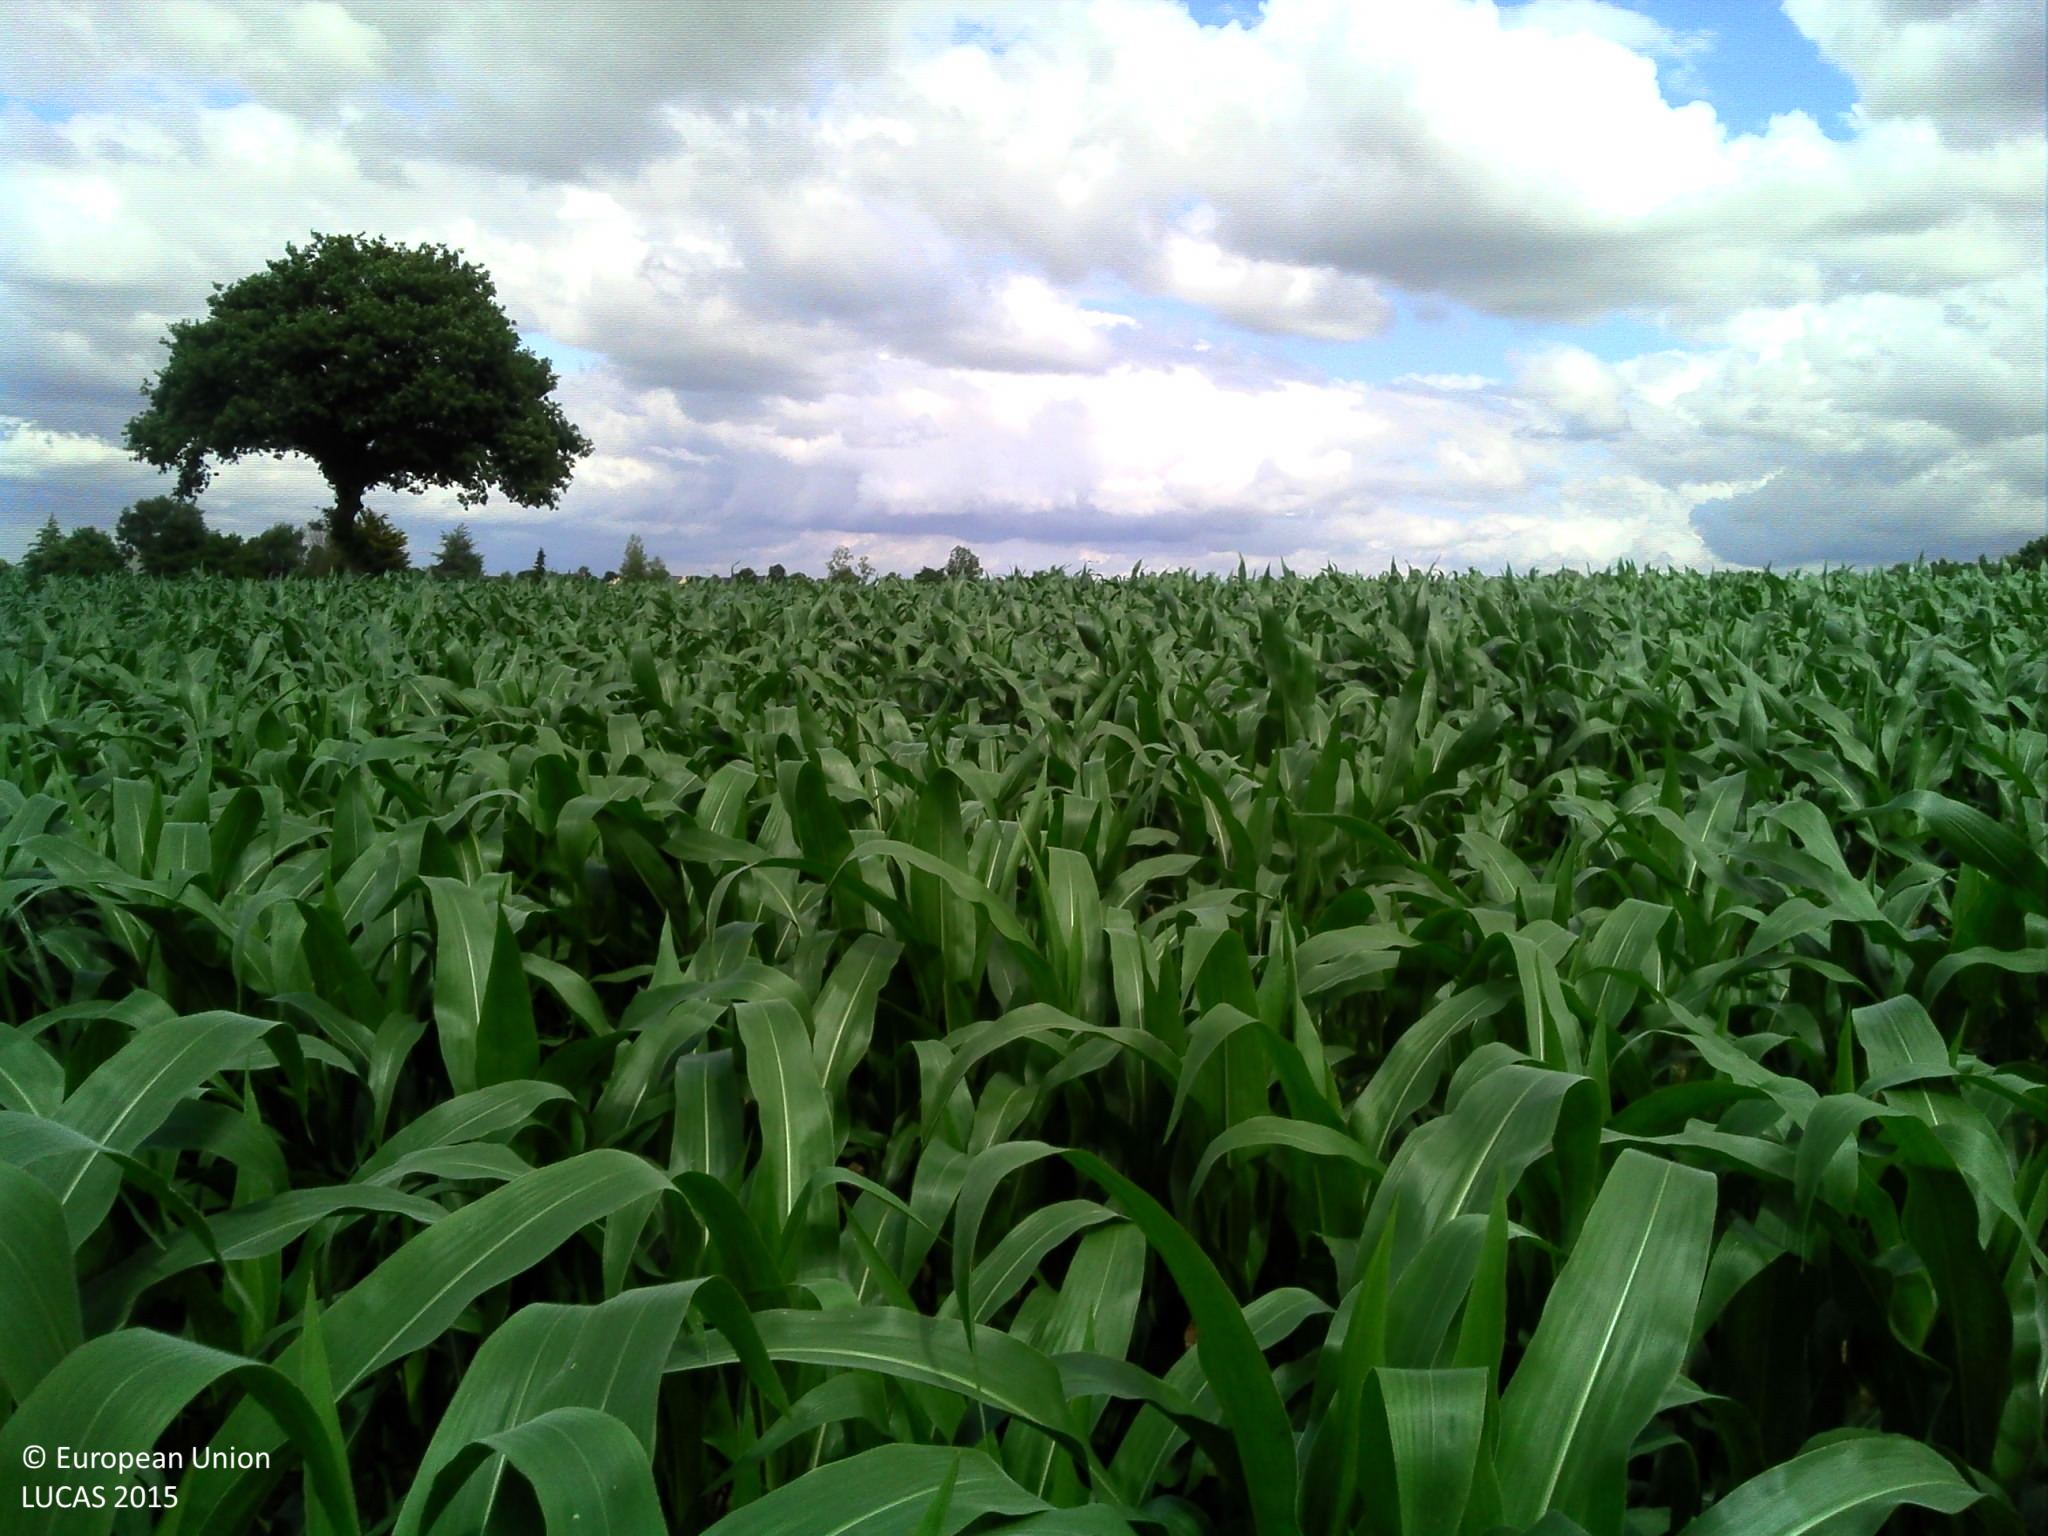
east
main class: Cropland
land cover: Maize
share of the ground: > 75 %
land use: Agriculture (excluding fallow land and kitchen gardens)
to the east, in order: Maize; Grass margins; Ditches and canals; Paved roads, cycling and walking lanes; Grass margins; Ditches and canals; Common wheat; Grass margins; Maize
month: July
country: FR
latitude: 48.2034
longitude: -2.1516
